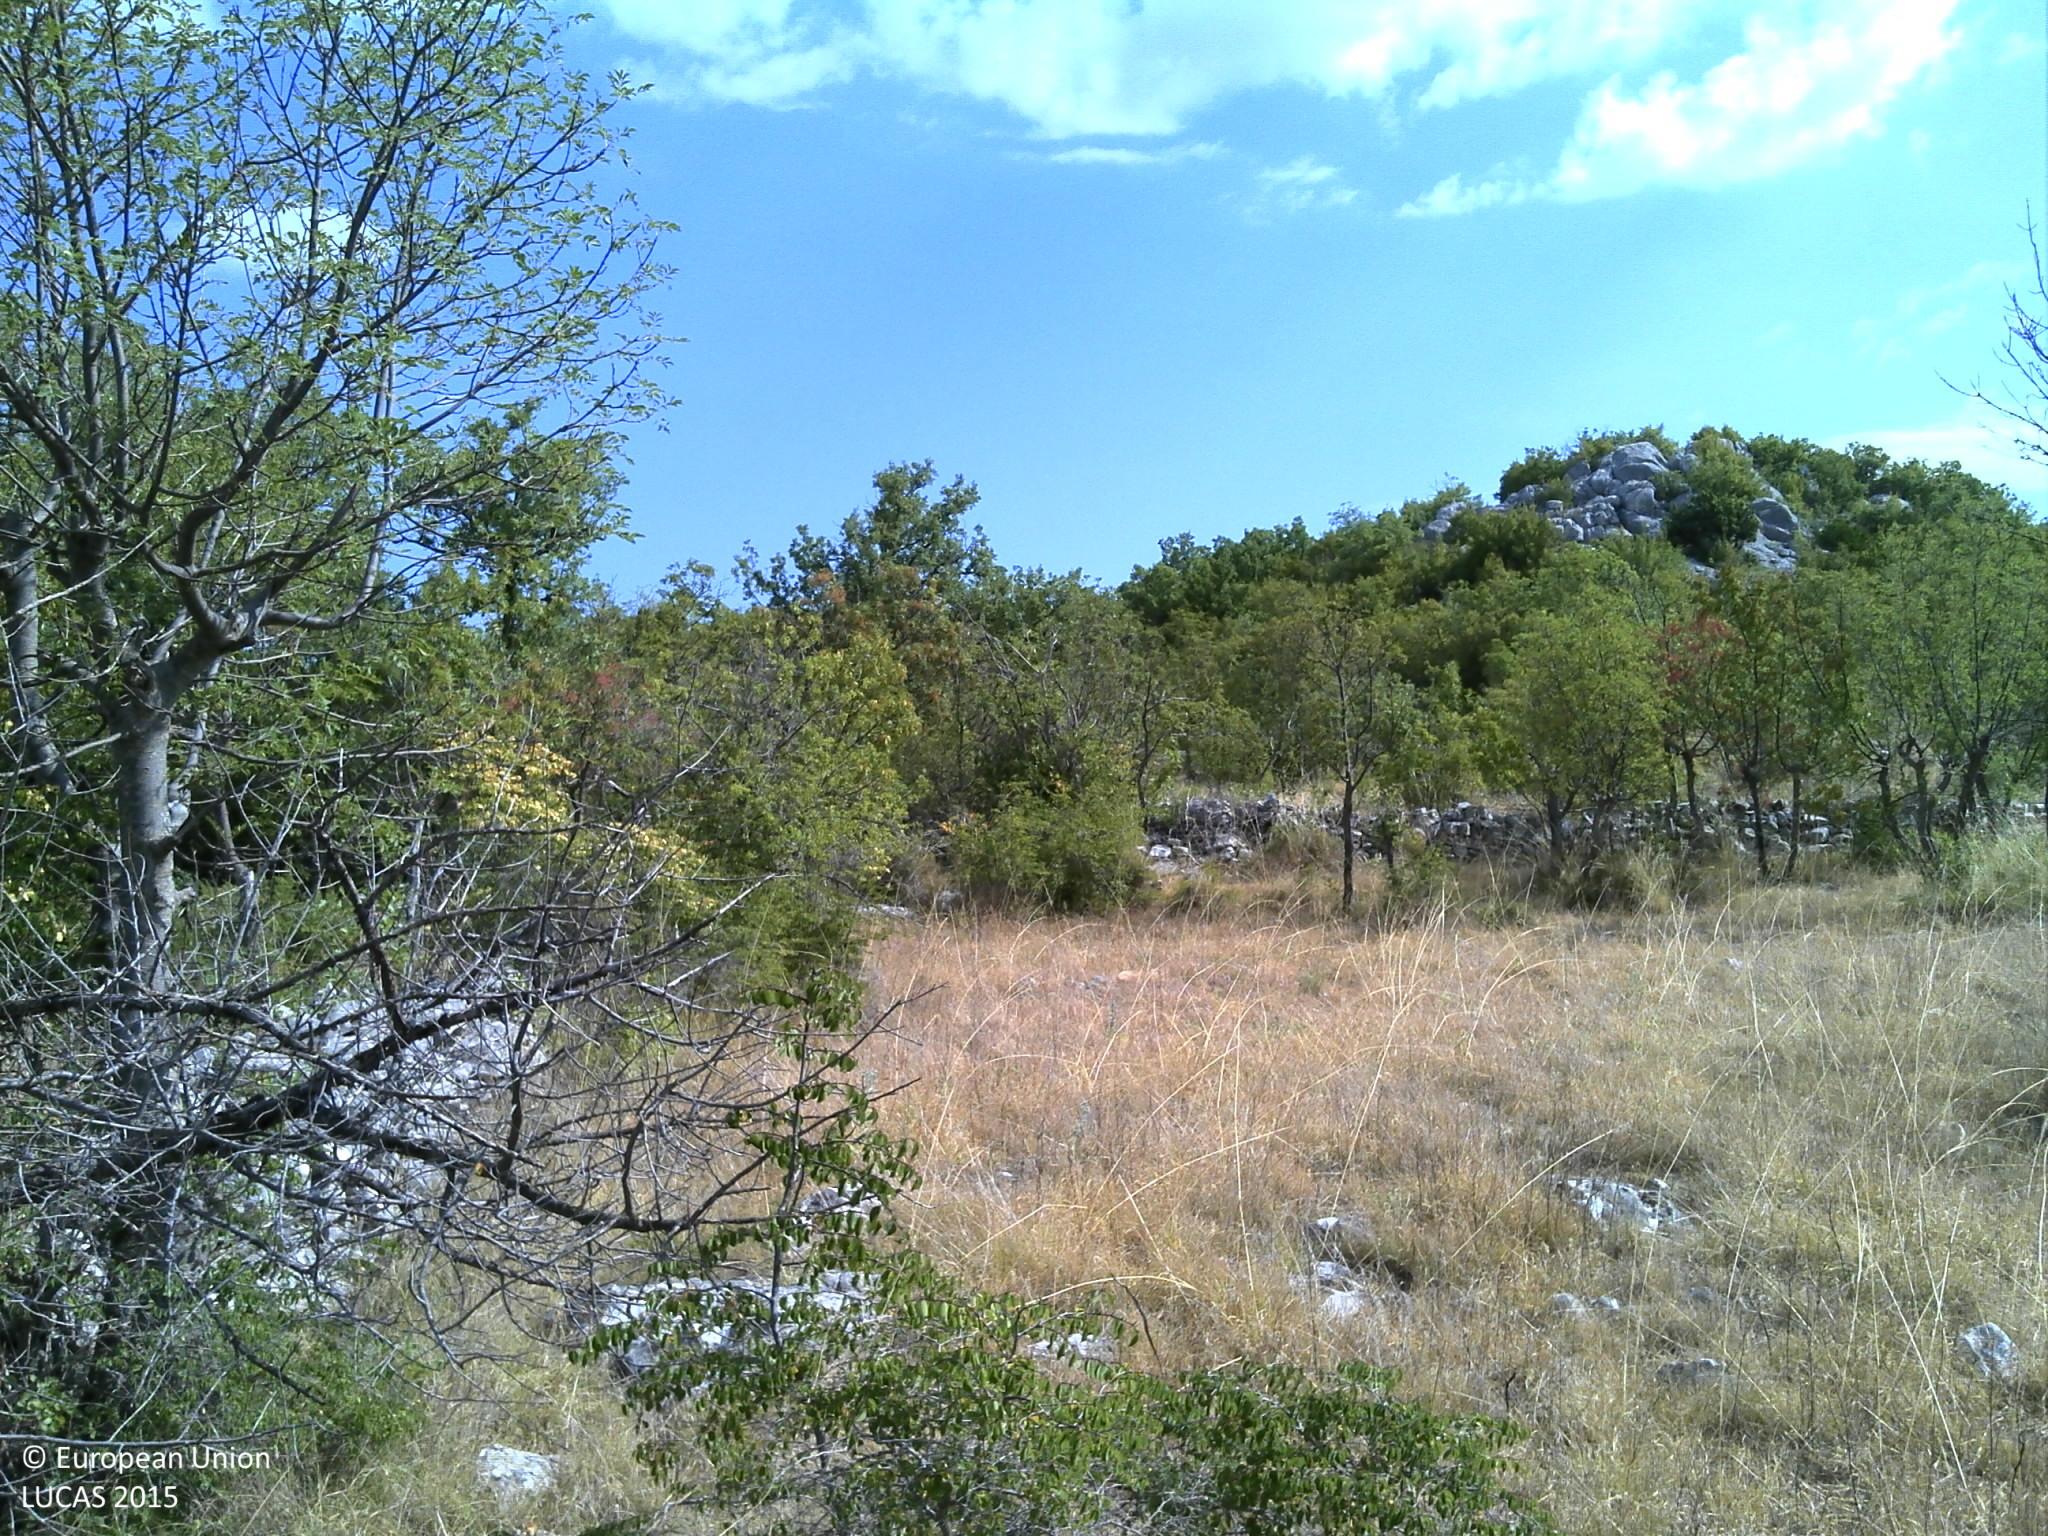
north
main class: Woodland
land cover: Broadleaved woodland
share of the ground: 10 - 25 %
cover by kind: herbaceous plants 70 %, broadleaved forest trees 15 %, shrubs 5 %, consolidated bare surface 5 %, unconsolidated bare surface 5 %
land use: Semi-natural and natural areas not in use
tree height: < 5 m
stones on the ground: < 10 %
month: July
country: HR
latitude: 43.7542
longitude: 16.1143
